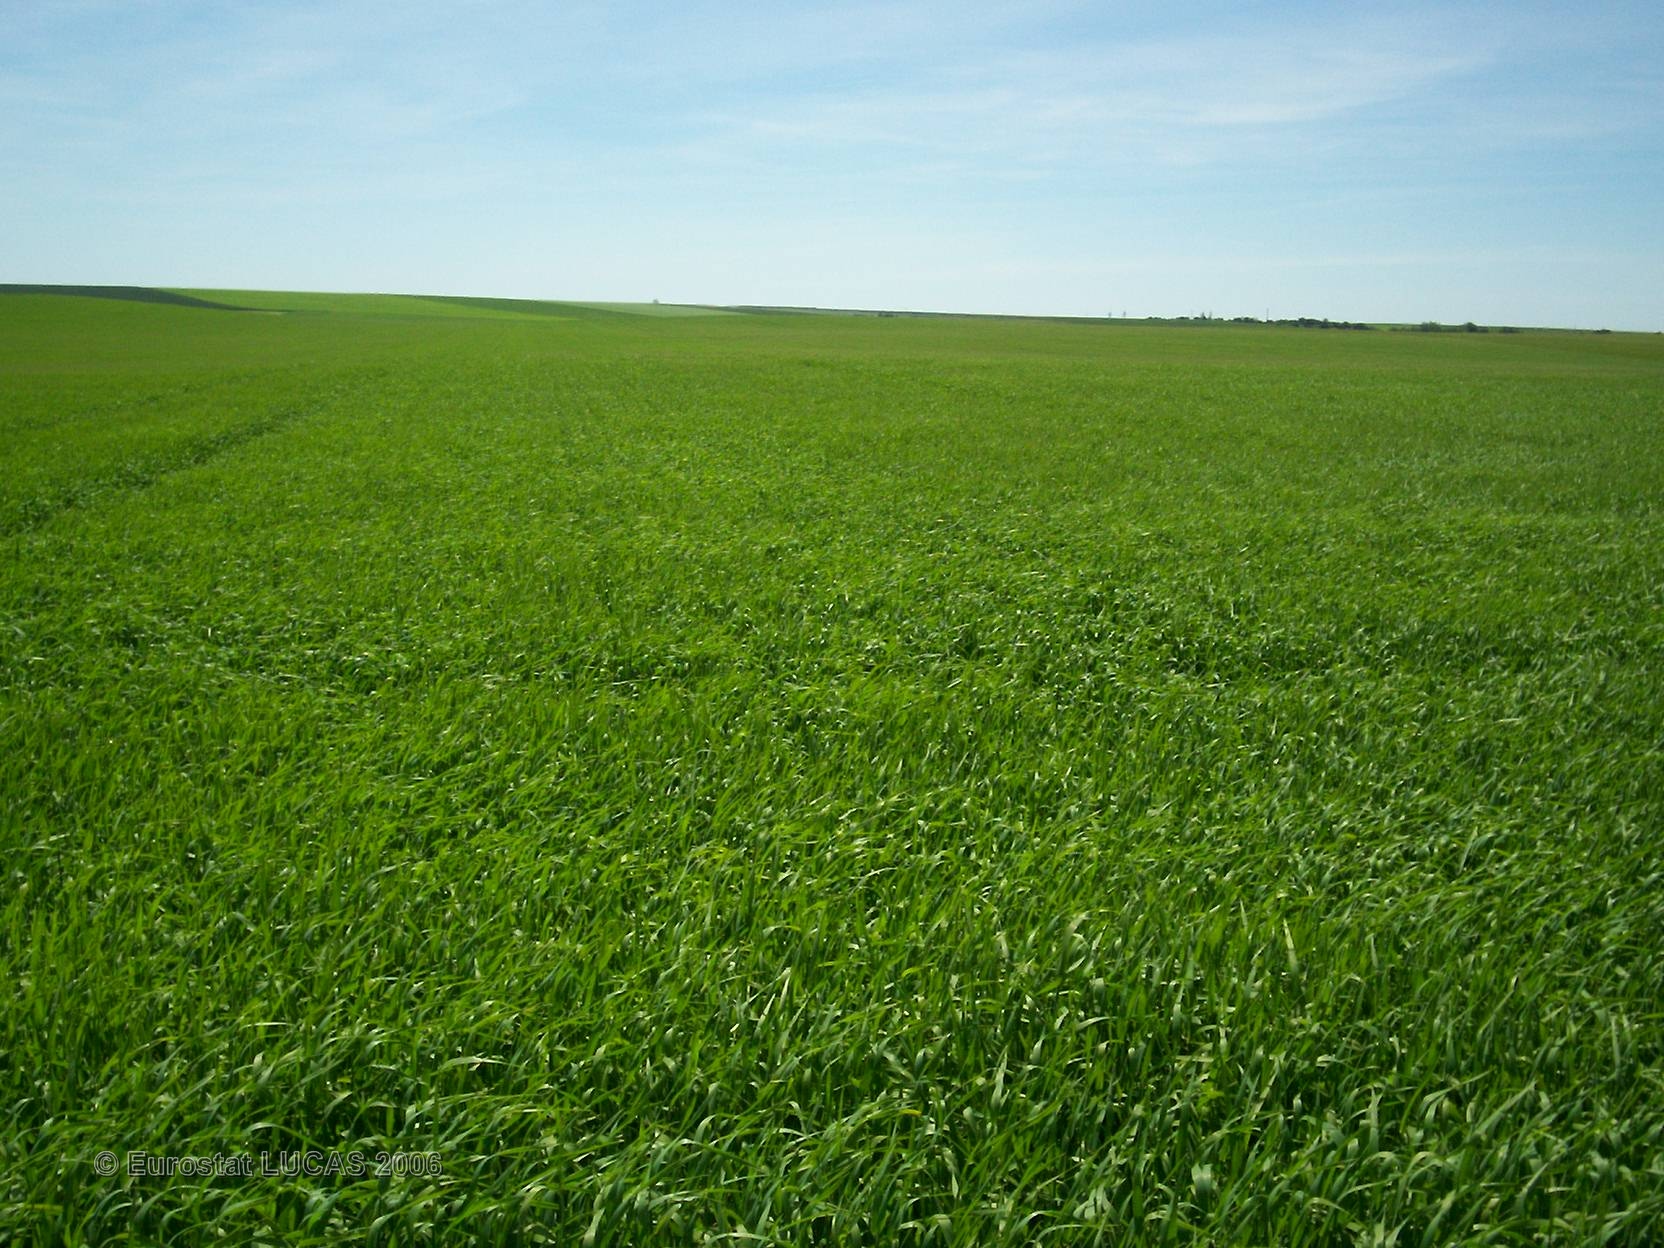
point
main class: Cropland
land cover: Barley
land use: Agriculture (excluding fallow land and kitchen gardens)
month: June
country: FR
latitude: 49.0465
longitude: 4.5926
